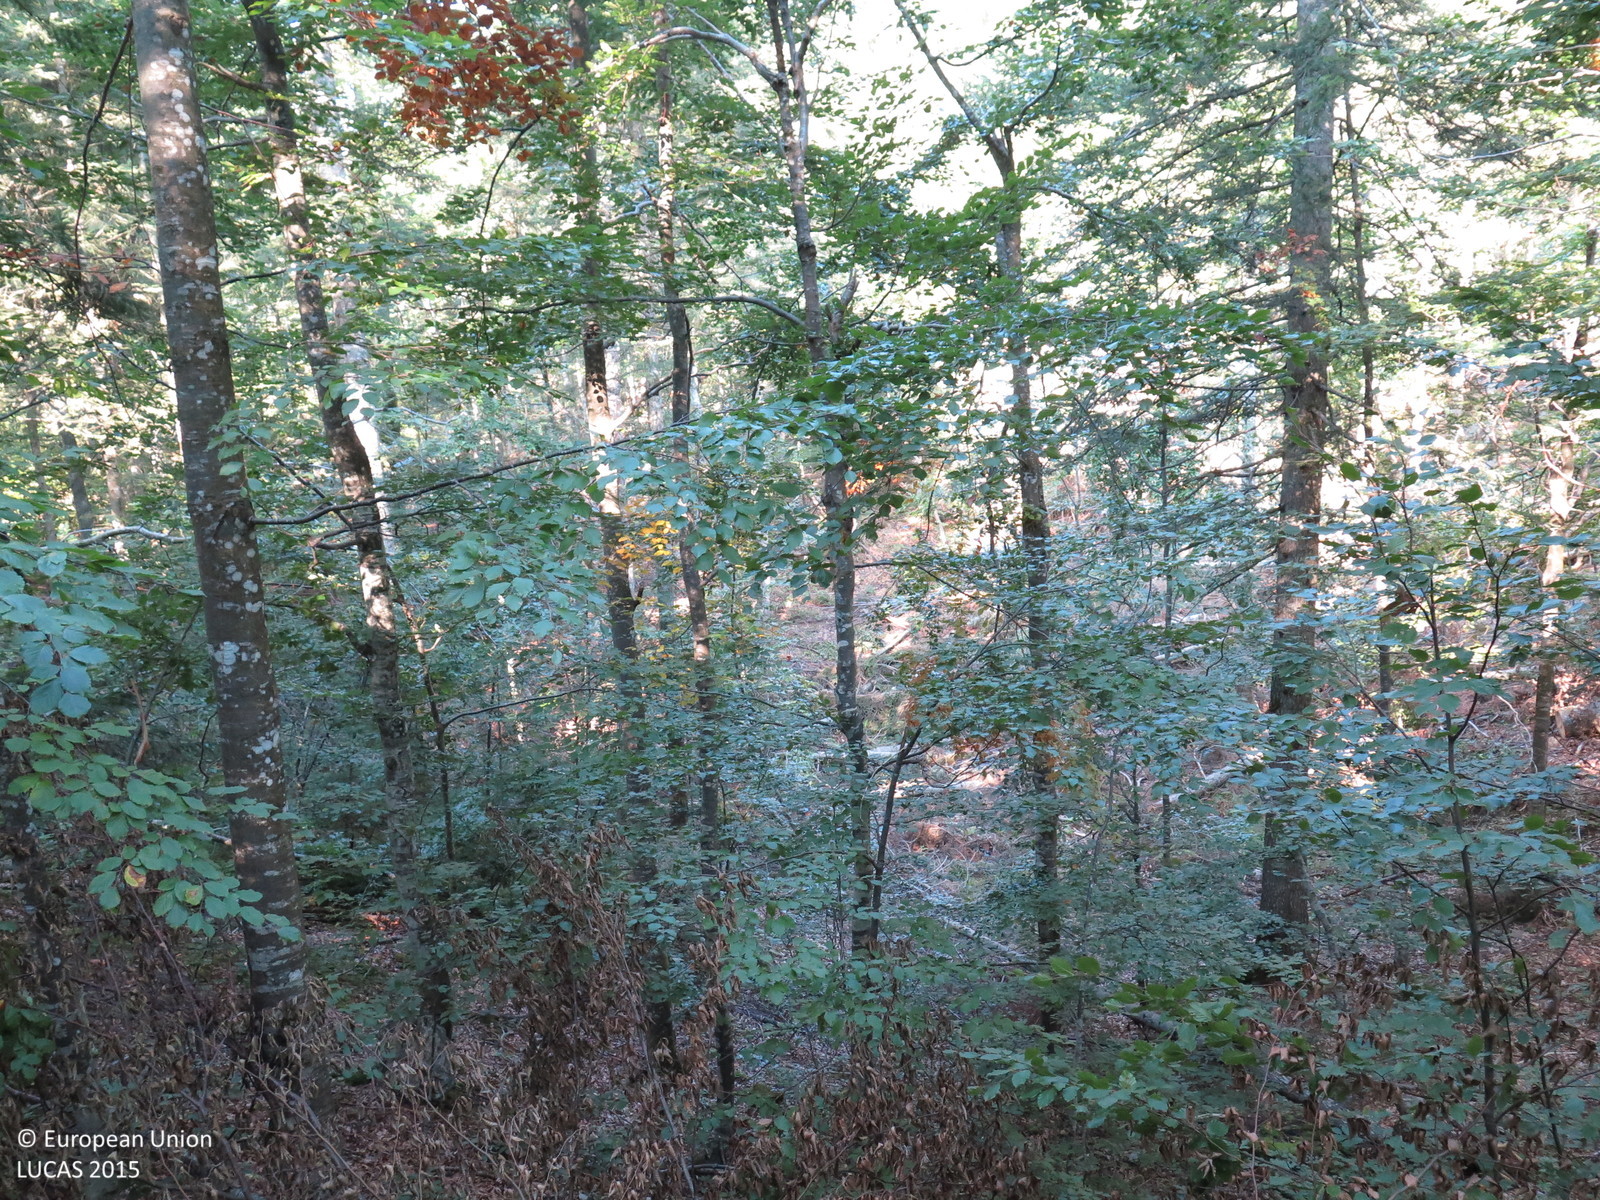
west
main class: Woodland
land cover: Other mixed woodland
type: mountainous beech forest
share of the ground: > 75 %
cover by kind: broadleaved forest trees 75 %, coniferous forest trees 25 %
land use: Forestry
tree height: > 5 m
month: September
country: HR
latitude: 45.5488
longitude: 14.5938
